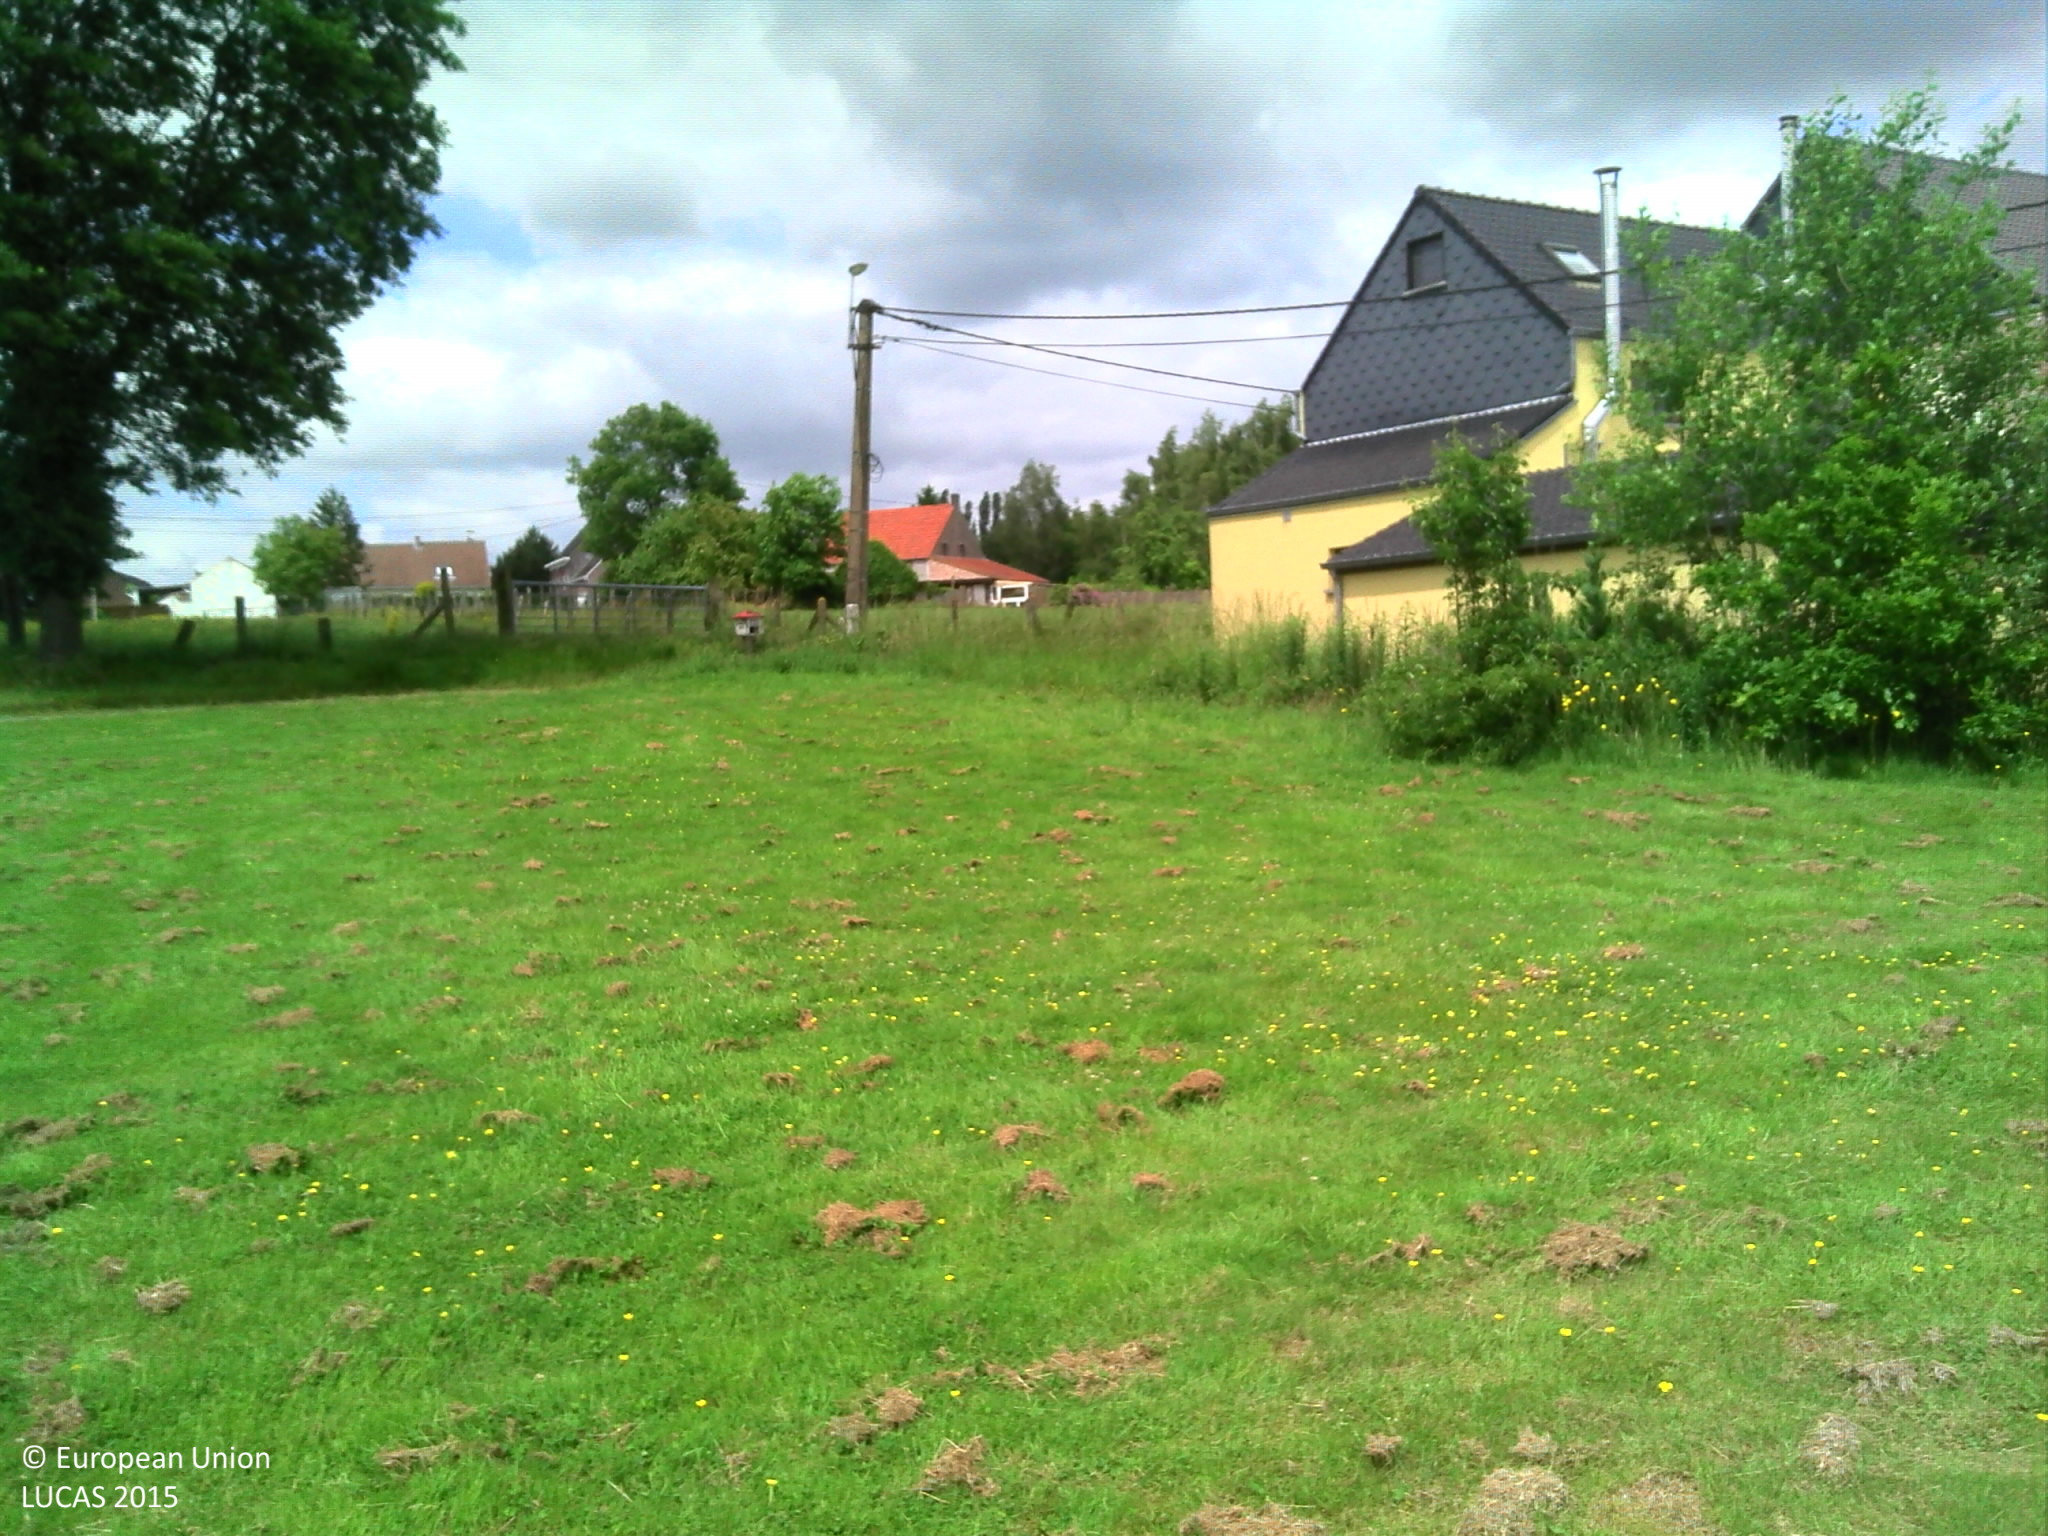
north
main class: Grassland
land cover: Grassland with sparse tree/shrub cover
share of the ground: > 75 %
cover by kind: herbaceous plants 95 %, broadleaved forest trees 5 %
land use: Agriculture (excluding fallow land and kitchen gardens)
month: June
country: BE
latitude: 50.8504
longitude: 3.9003
